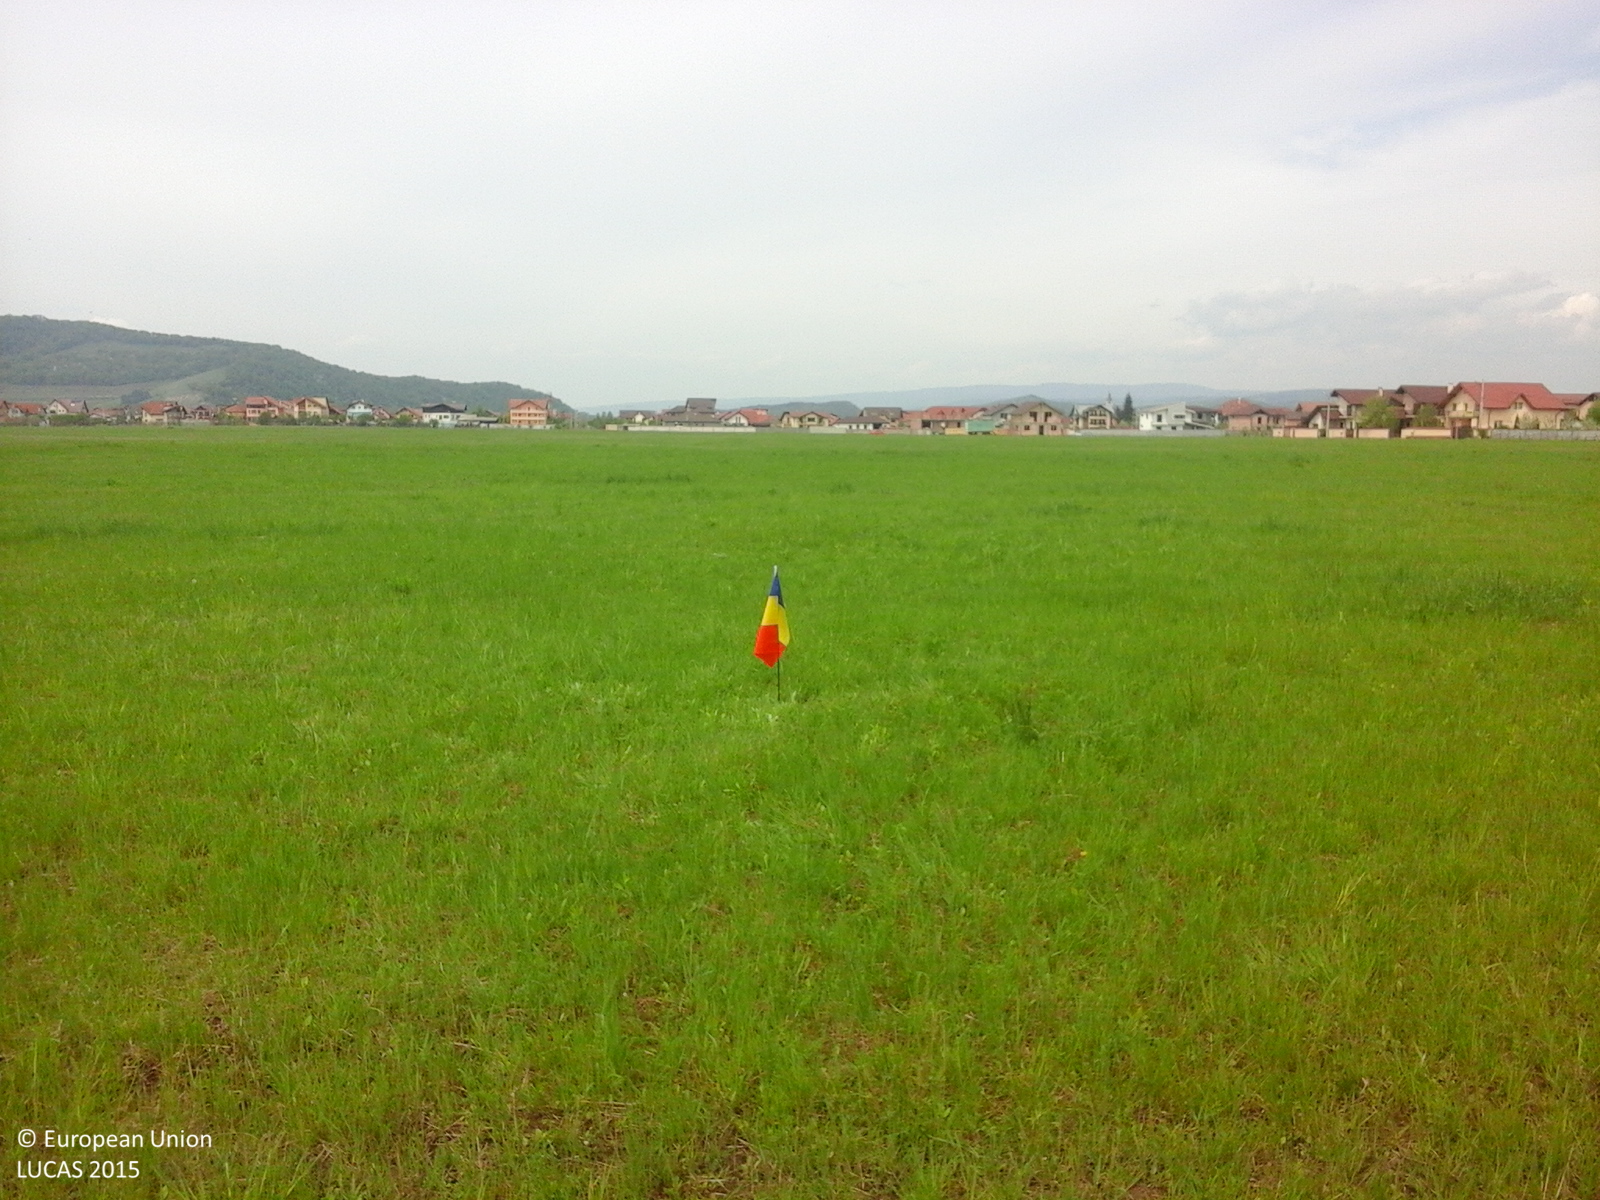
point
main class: Grassland
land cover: Grassland without tree/shrub cover
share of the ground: > 75 %
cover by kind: herbaceous plants 100 %
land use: Agriculture (excluding fallow land and kitchen gardens)
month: May
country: RO
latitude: 45.6983
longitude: 25.6852
